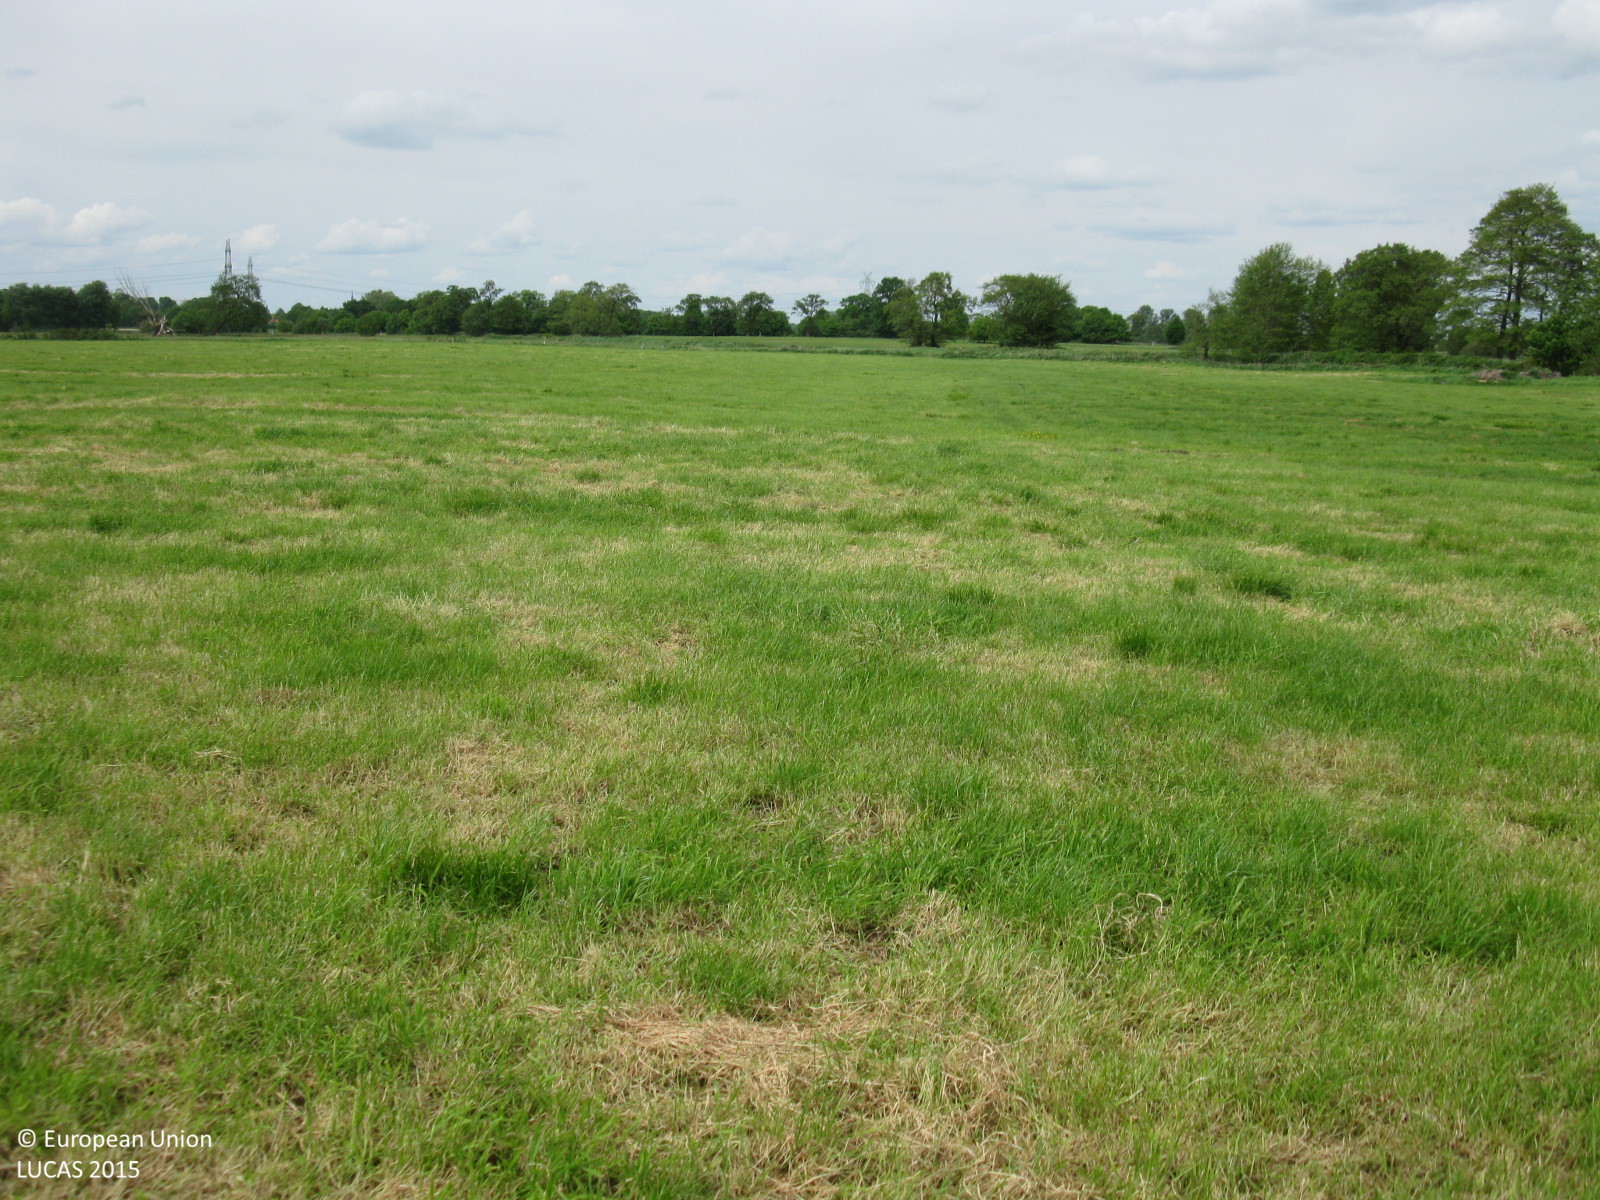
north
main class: Grassland
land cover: Grassland without tree/shrub cover
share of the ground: > 75 %
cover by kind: herbaceous plants 100 %
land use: Agriculture (excluding fallow land and kitchen gardens)
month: June
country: DE
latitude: 53.1207
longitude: 7.3258
